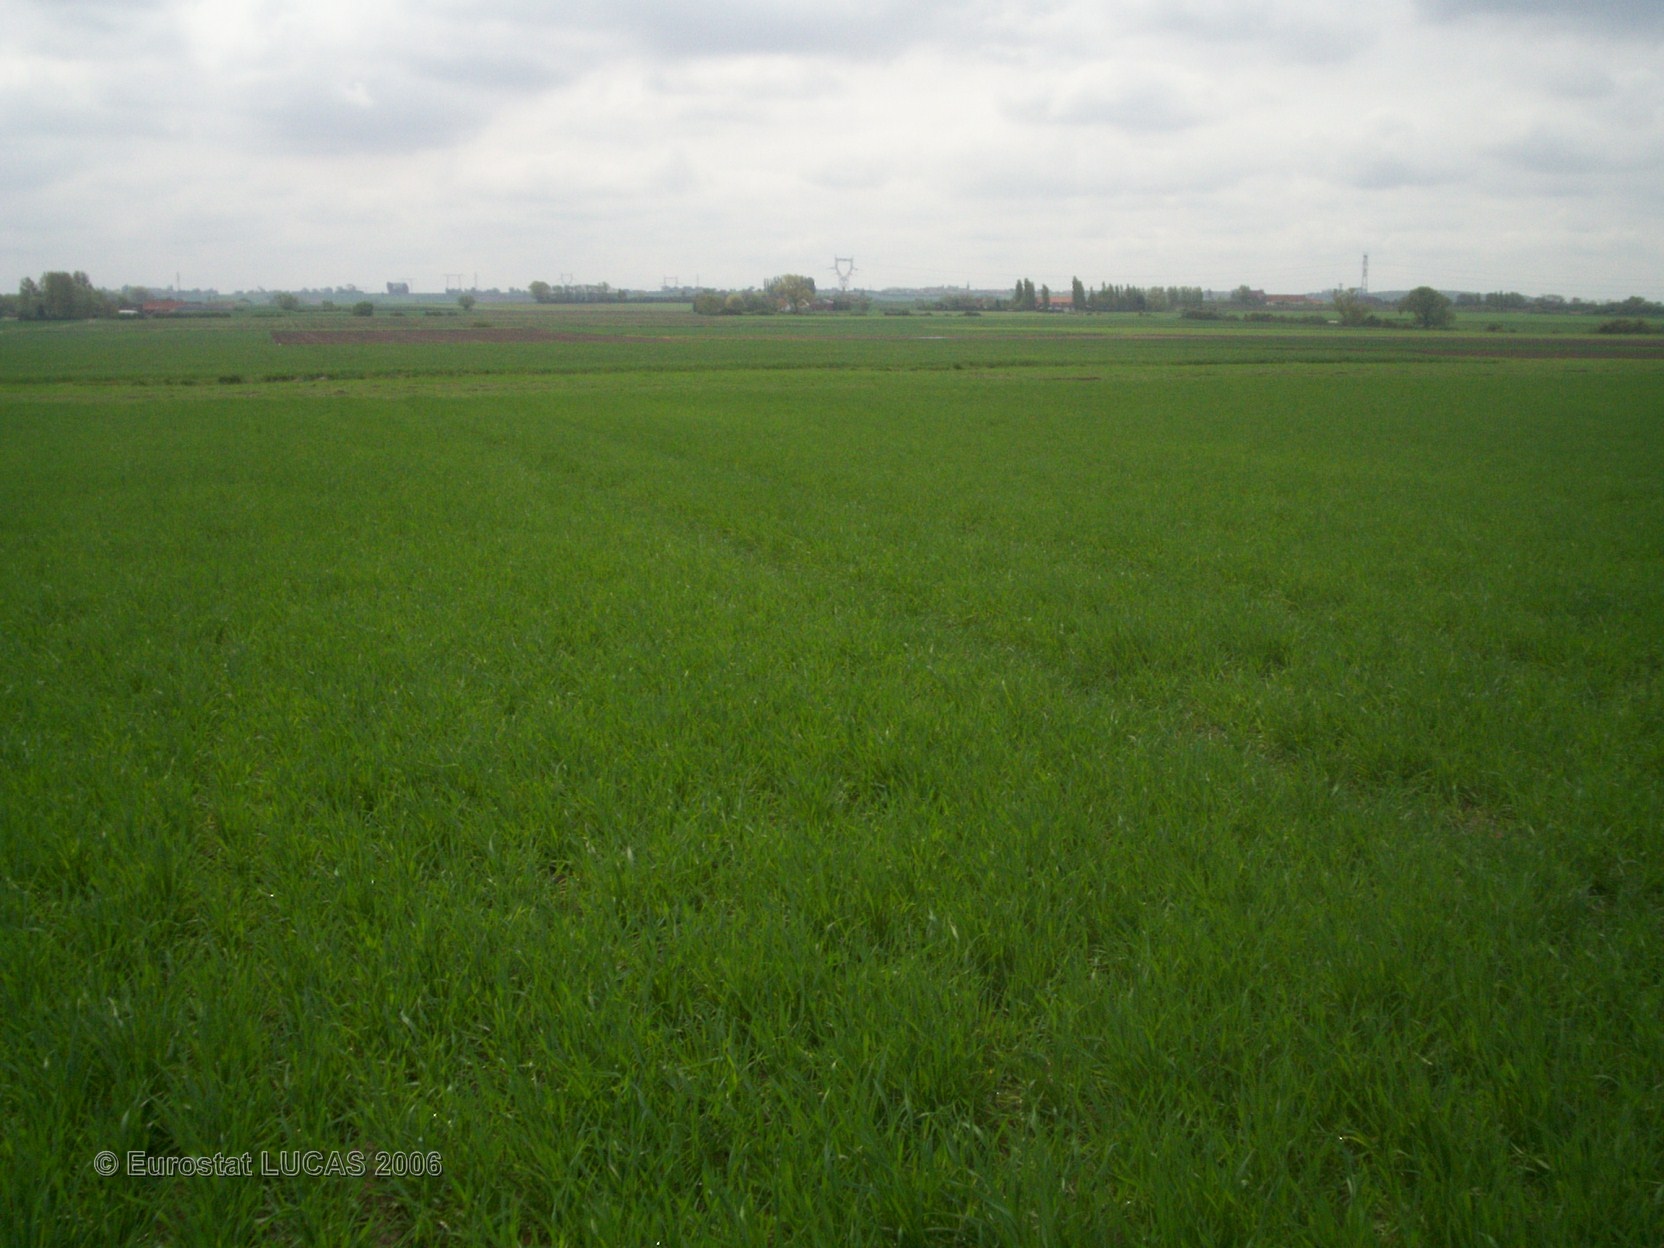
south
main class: Cropland
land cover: Common wheat
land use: Agriculture (excluding fallow land and kitchen gardens)
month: May
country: FR
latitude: 50.8987
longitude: 2.2937
